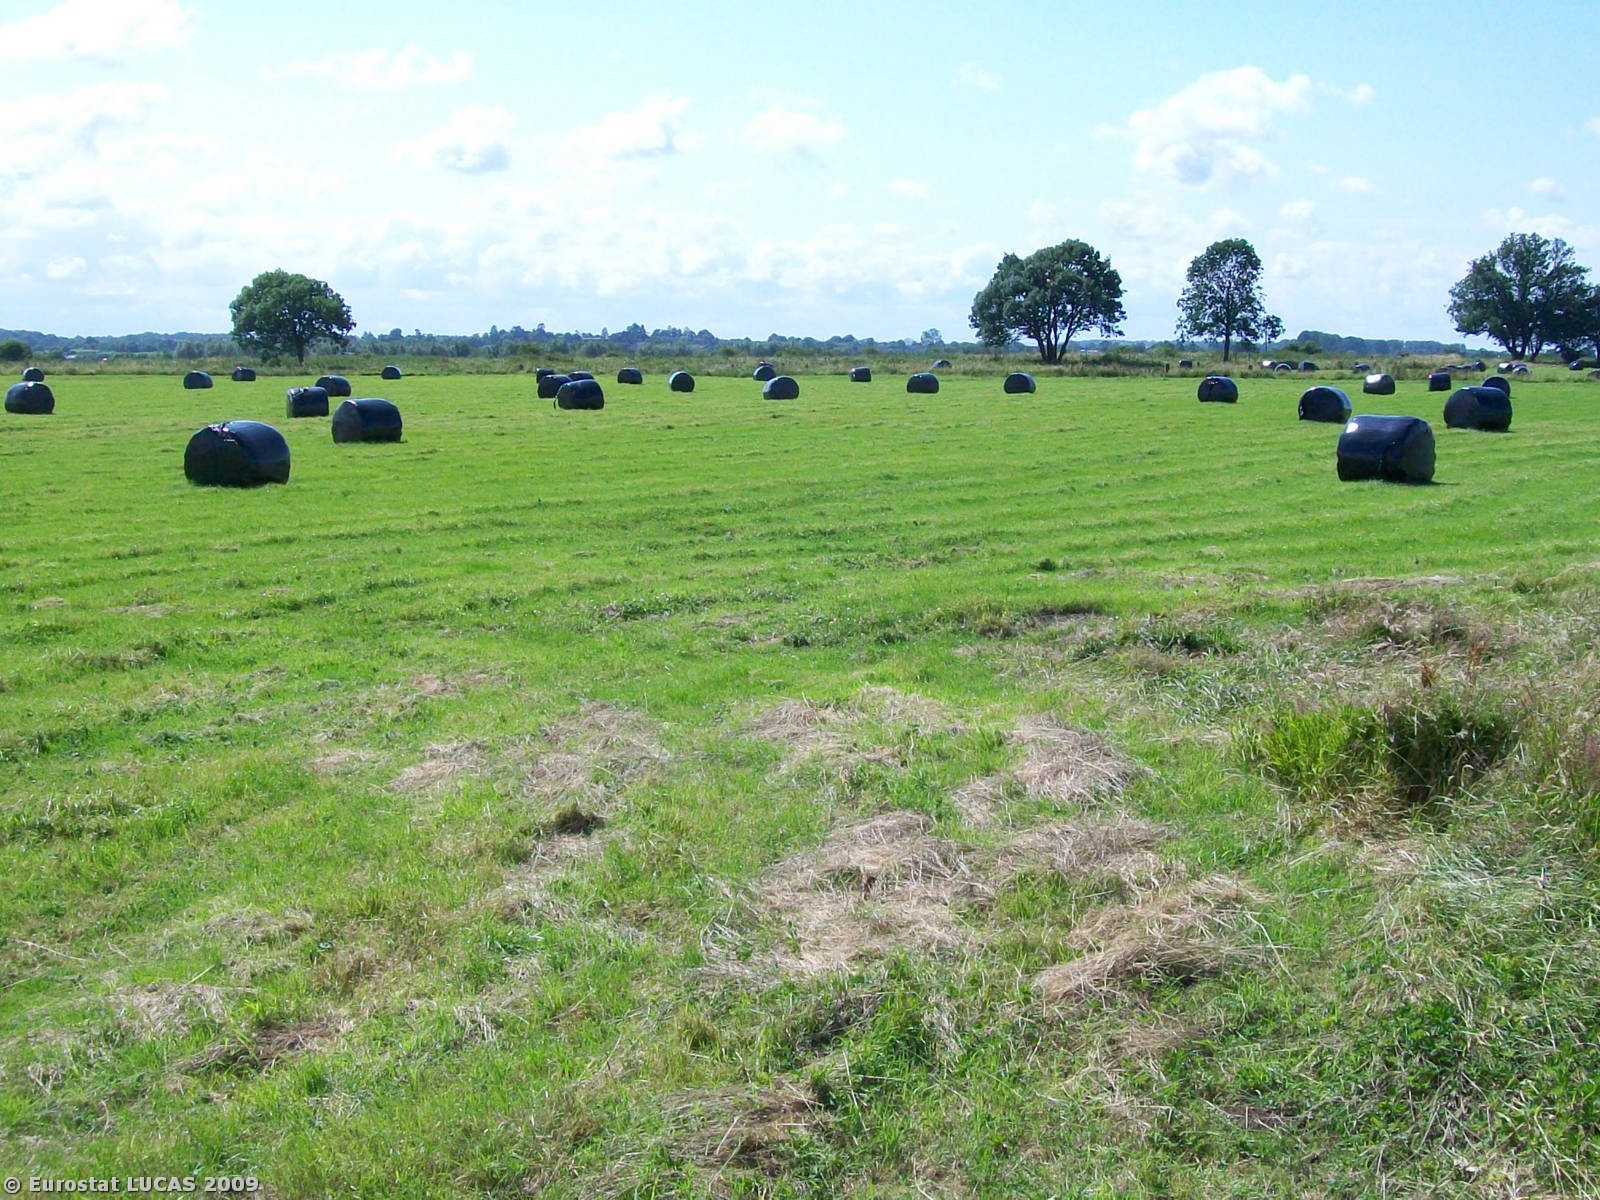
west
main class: Grassland
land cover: Grassland without tree/shrub cover
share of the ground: > 75 %
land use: Agriculture (excluding fallow land and kitchen gardens)
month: July
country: GB
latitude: 51.1288
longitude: -2.6870
